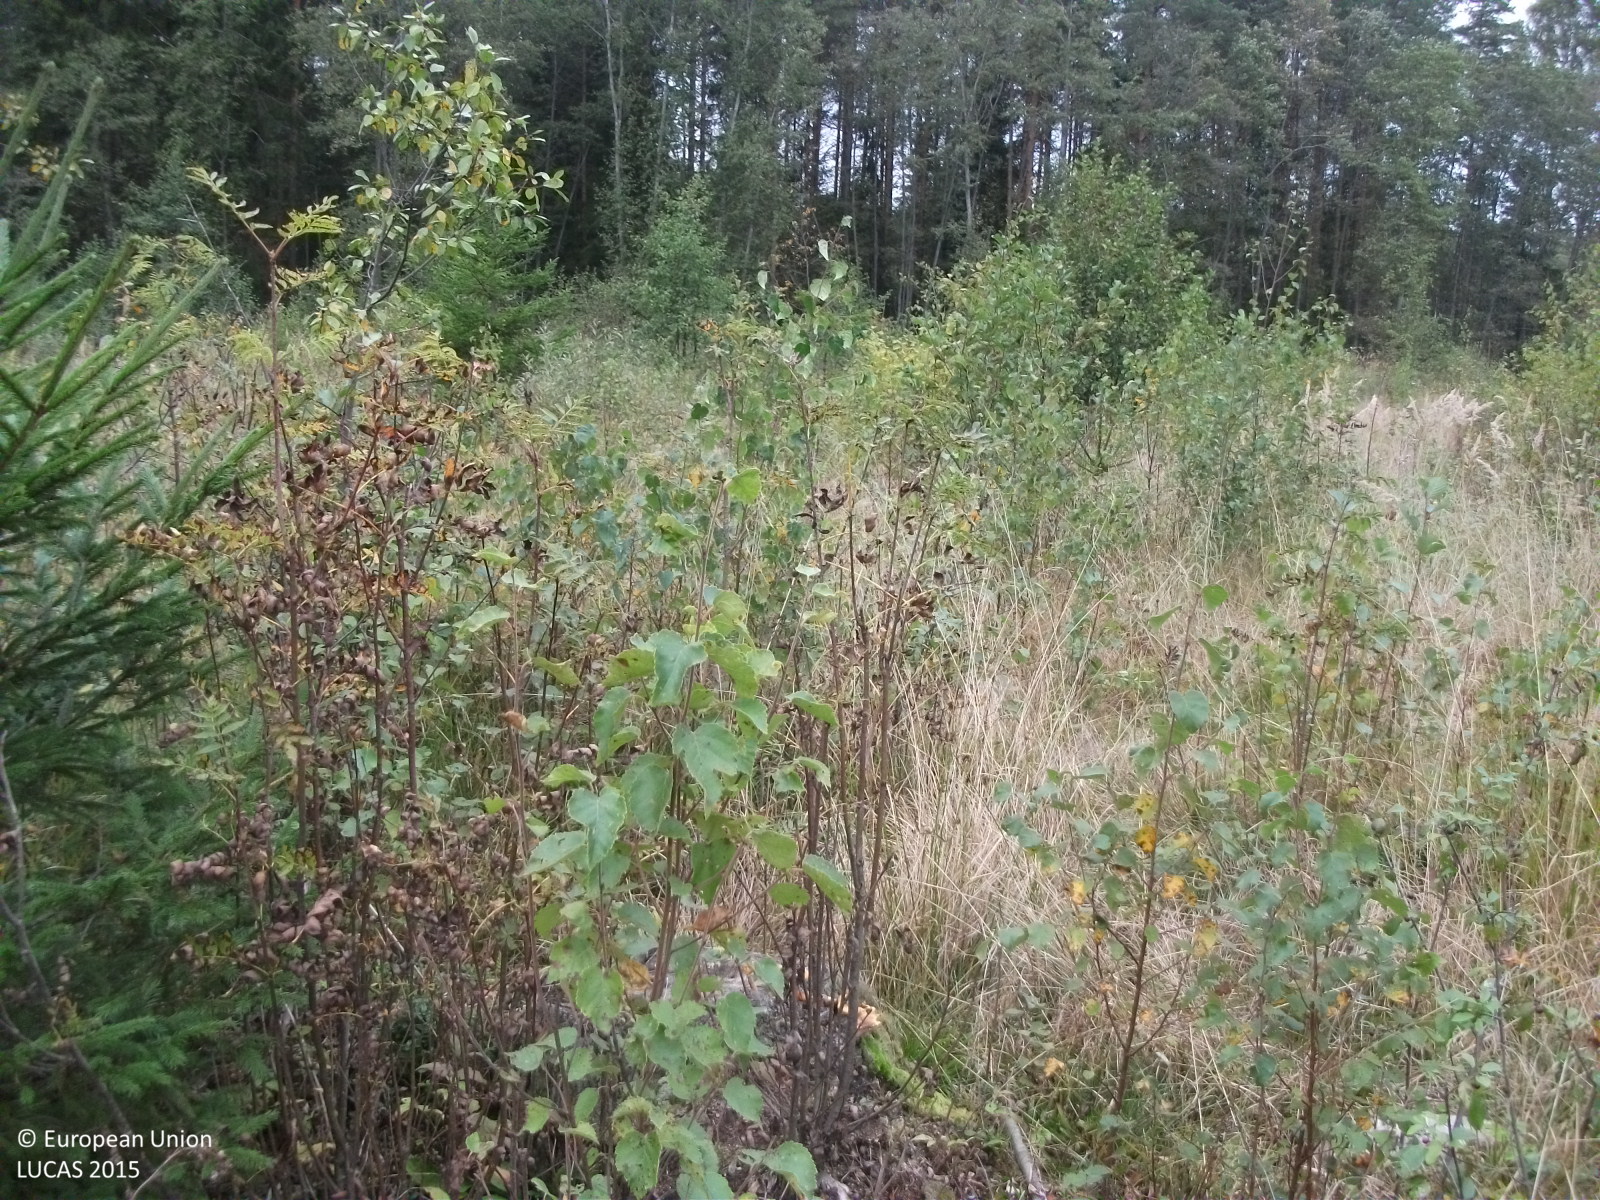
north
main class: Woodland
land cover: Spruce dominated mixed woodland
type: hemiboreal forest and nemoral coniferous forest and mixed broadleaved-coniferous forest
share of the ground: 25 - 50 %
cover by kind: broadleaved forest trees 30 %, shrubs 30 %, herbaceous plants 25 %, coniferous forest trees 15 %
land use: Forestry
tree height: < 5 m
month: September
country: LV
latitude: 57.9084
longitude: 24.6218
